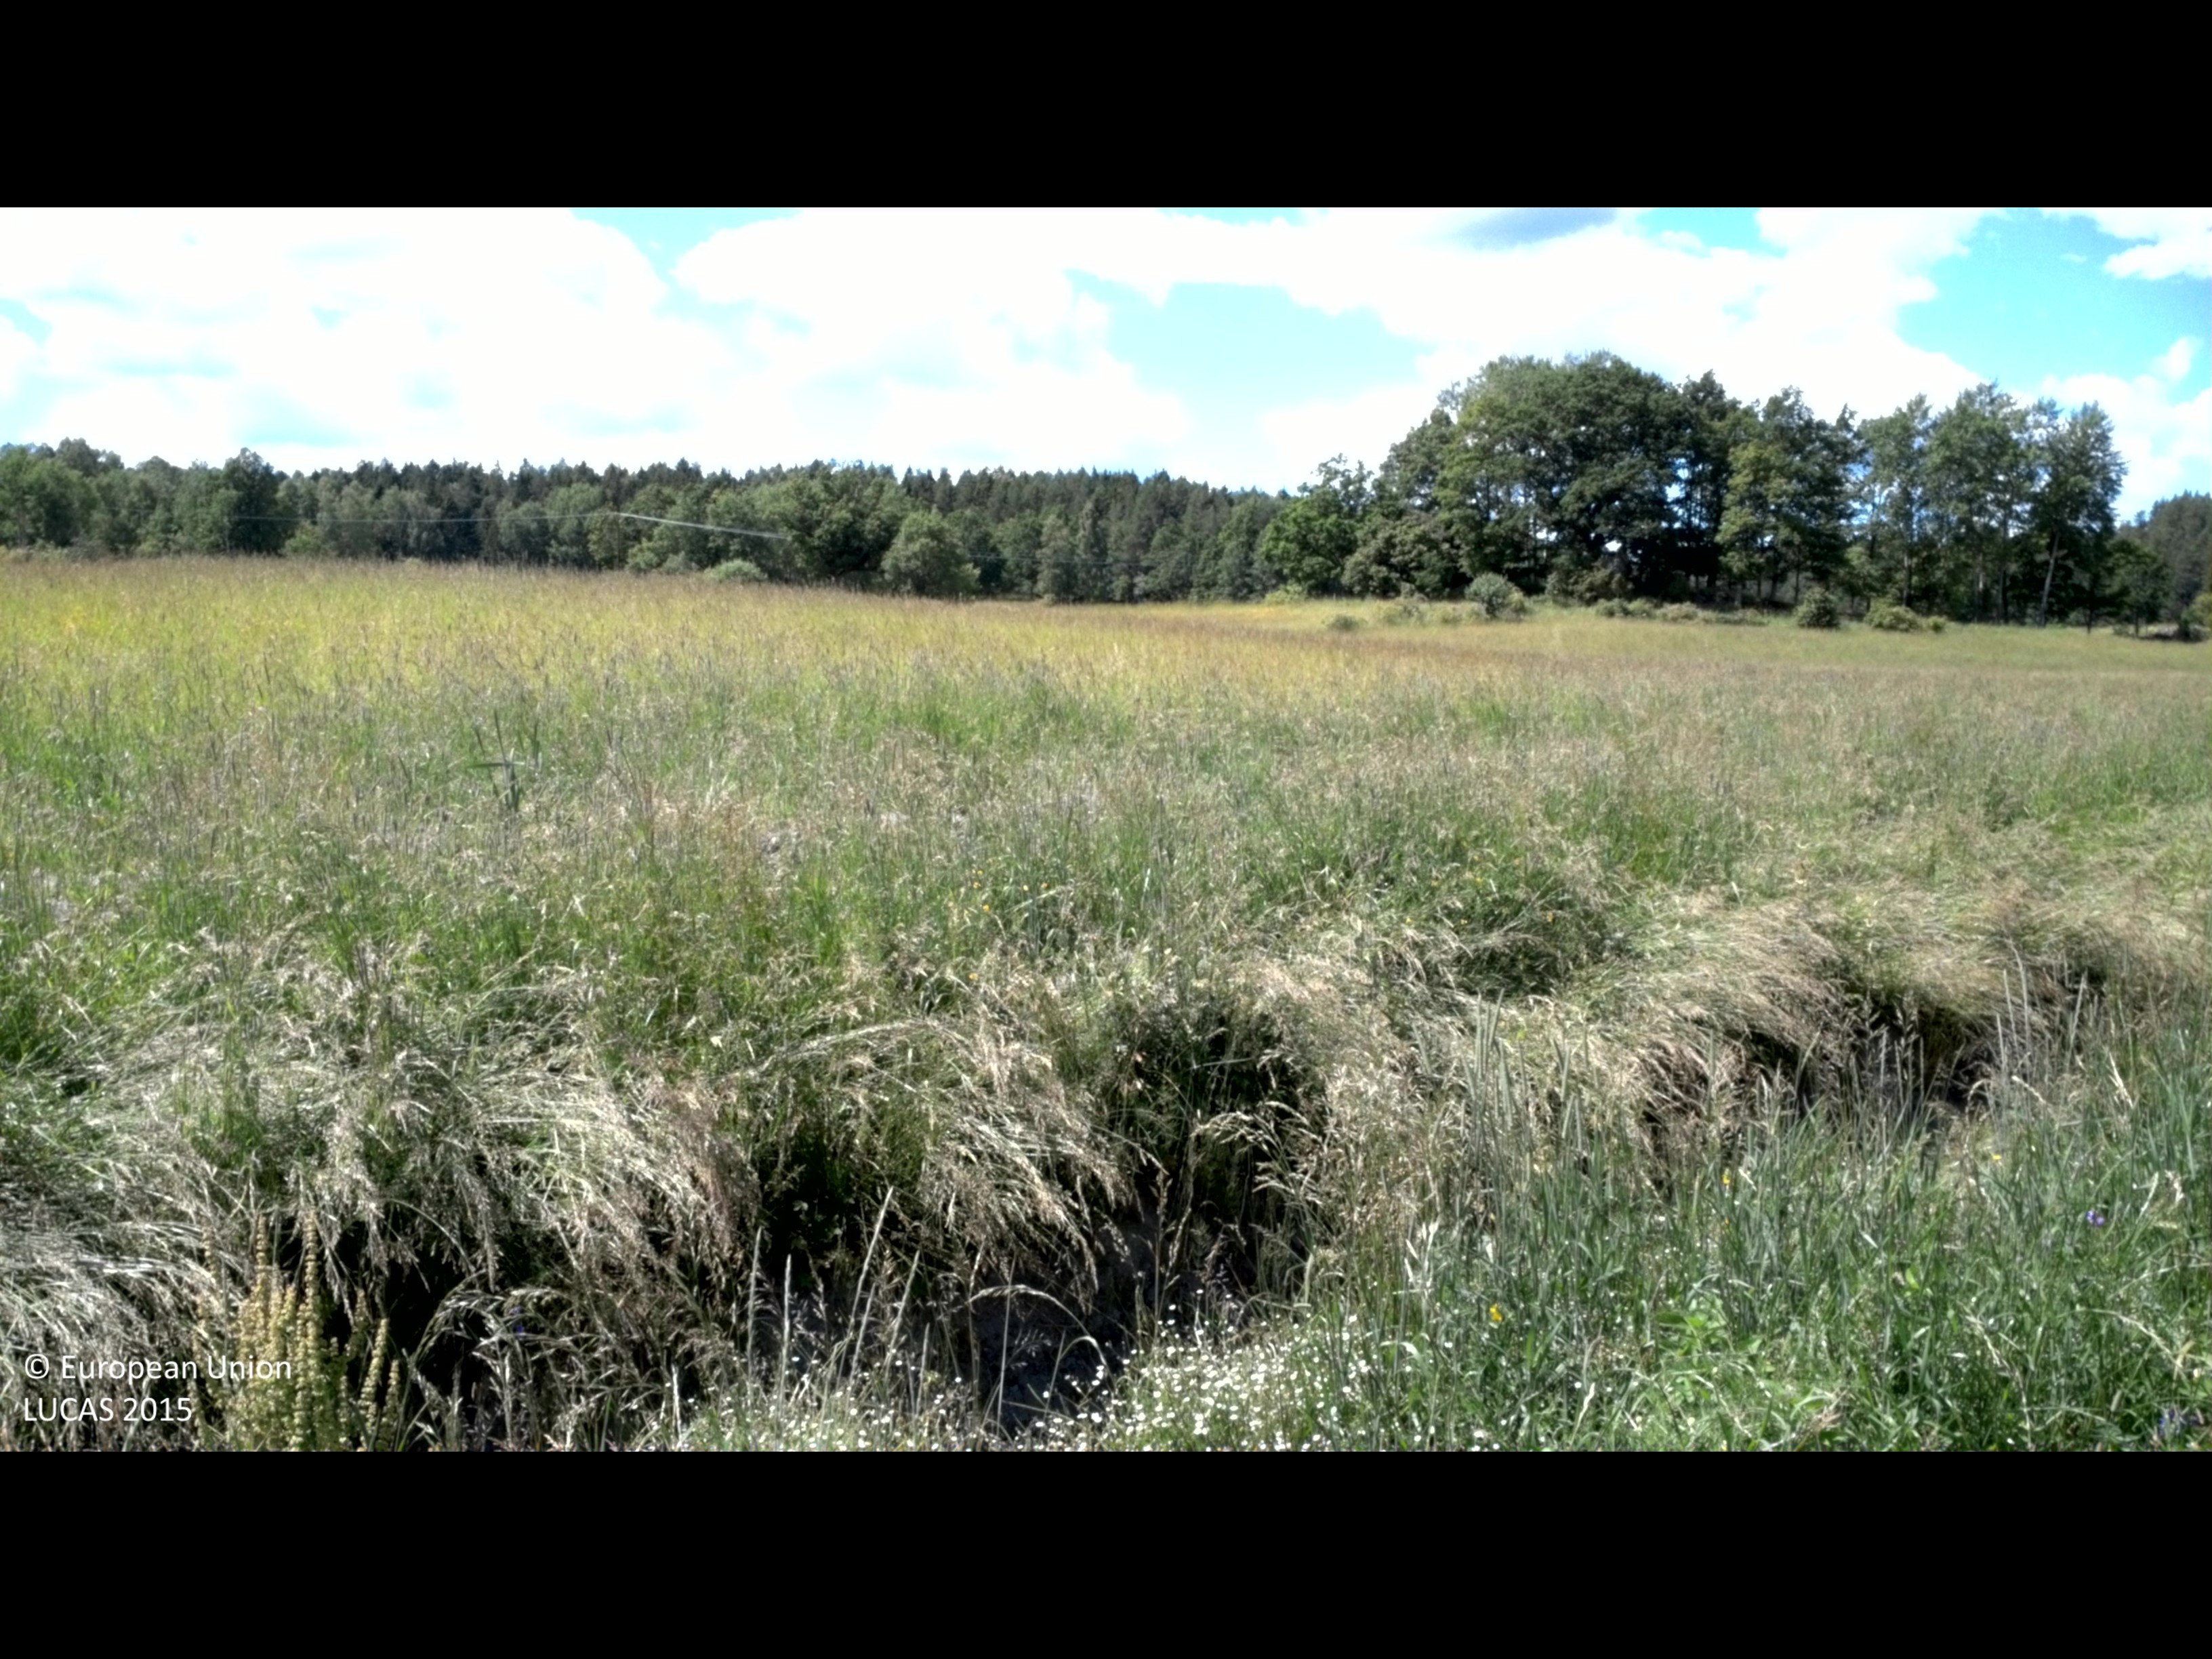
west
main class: Grassland
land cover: Spontaneously vegetated surfaces
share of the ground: > 75 %
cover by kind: herbaceous plants 90 %, unconsolidated bare surface 10 %
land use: Fallow land
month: July
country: SE
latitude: 58.2499
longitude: 16.3518
